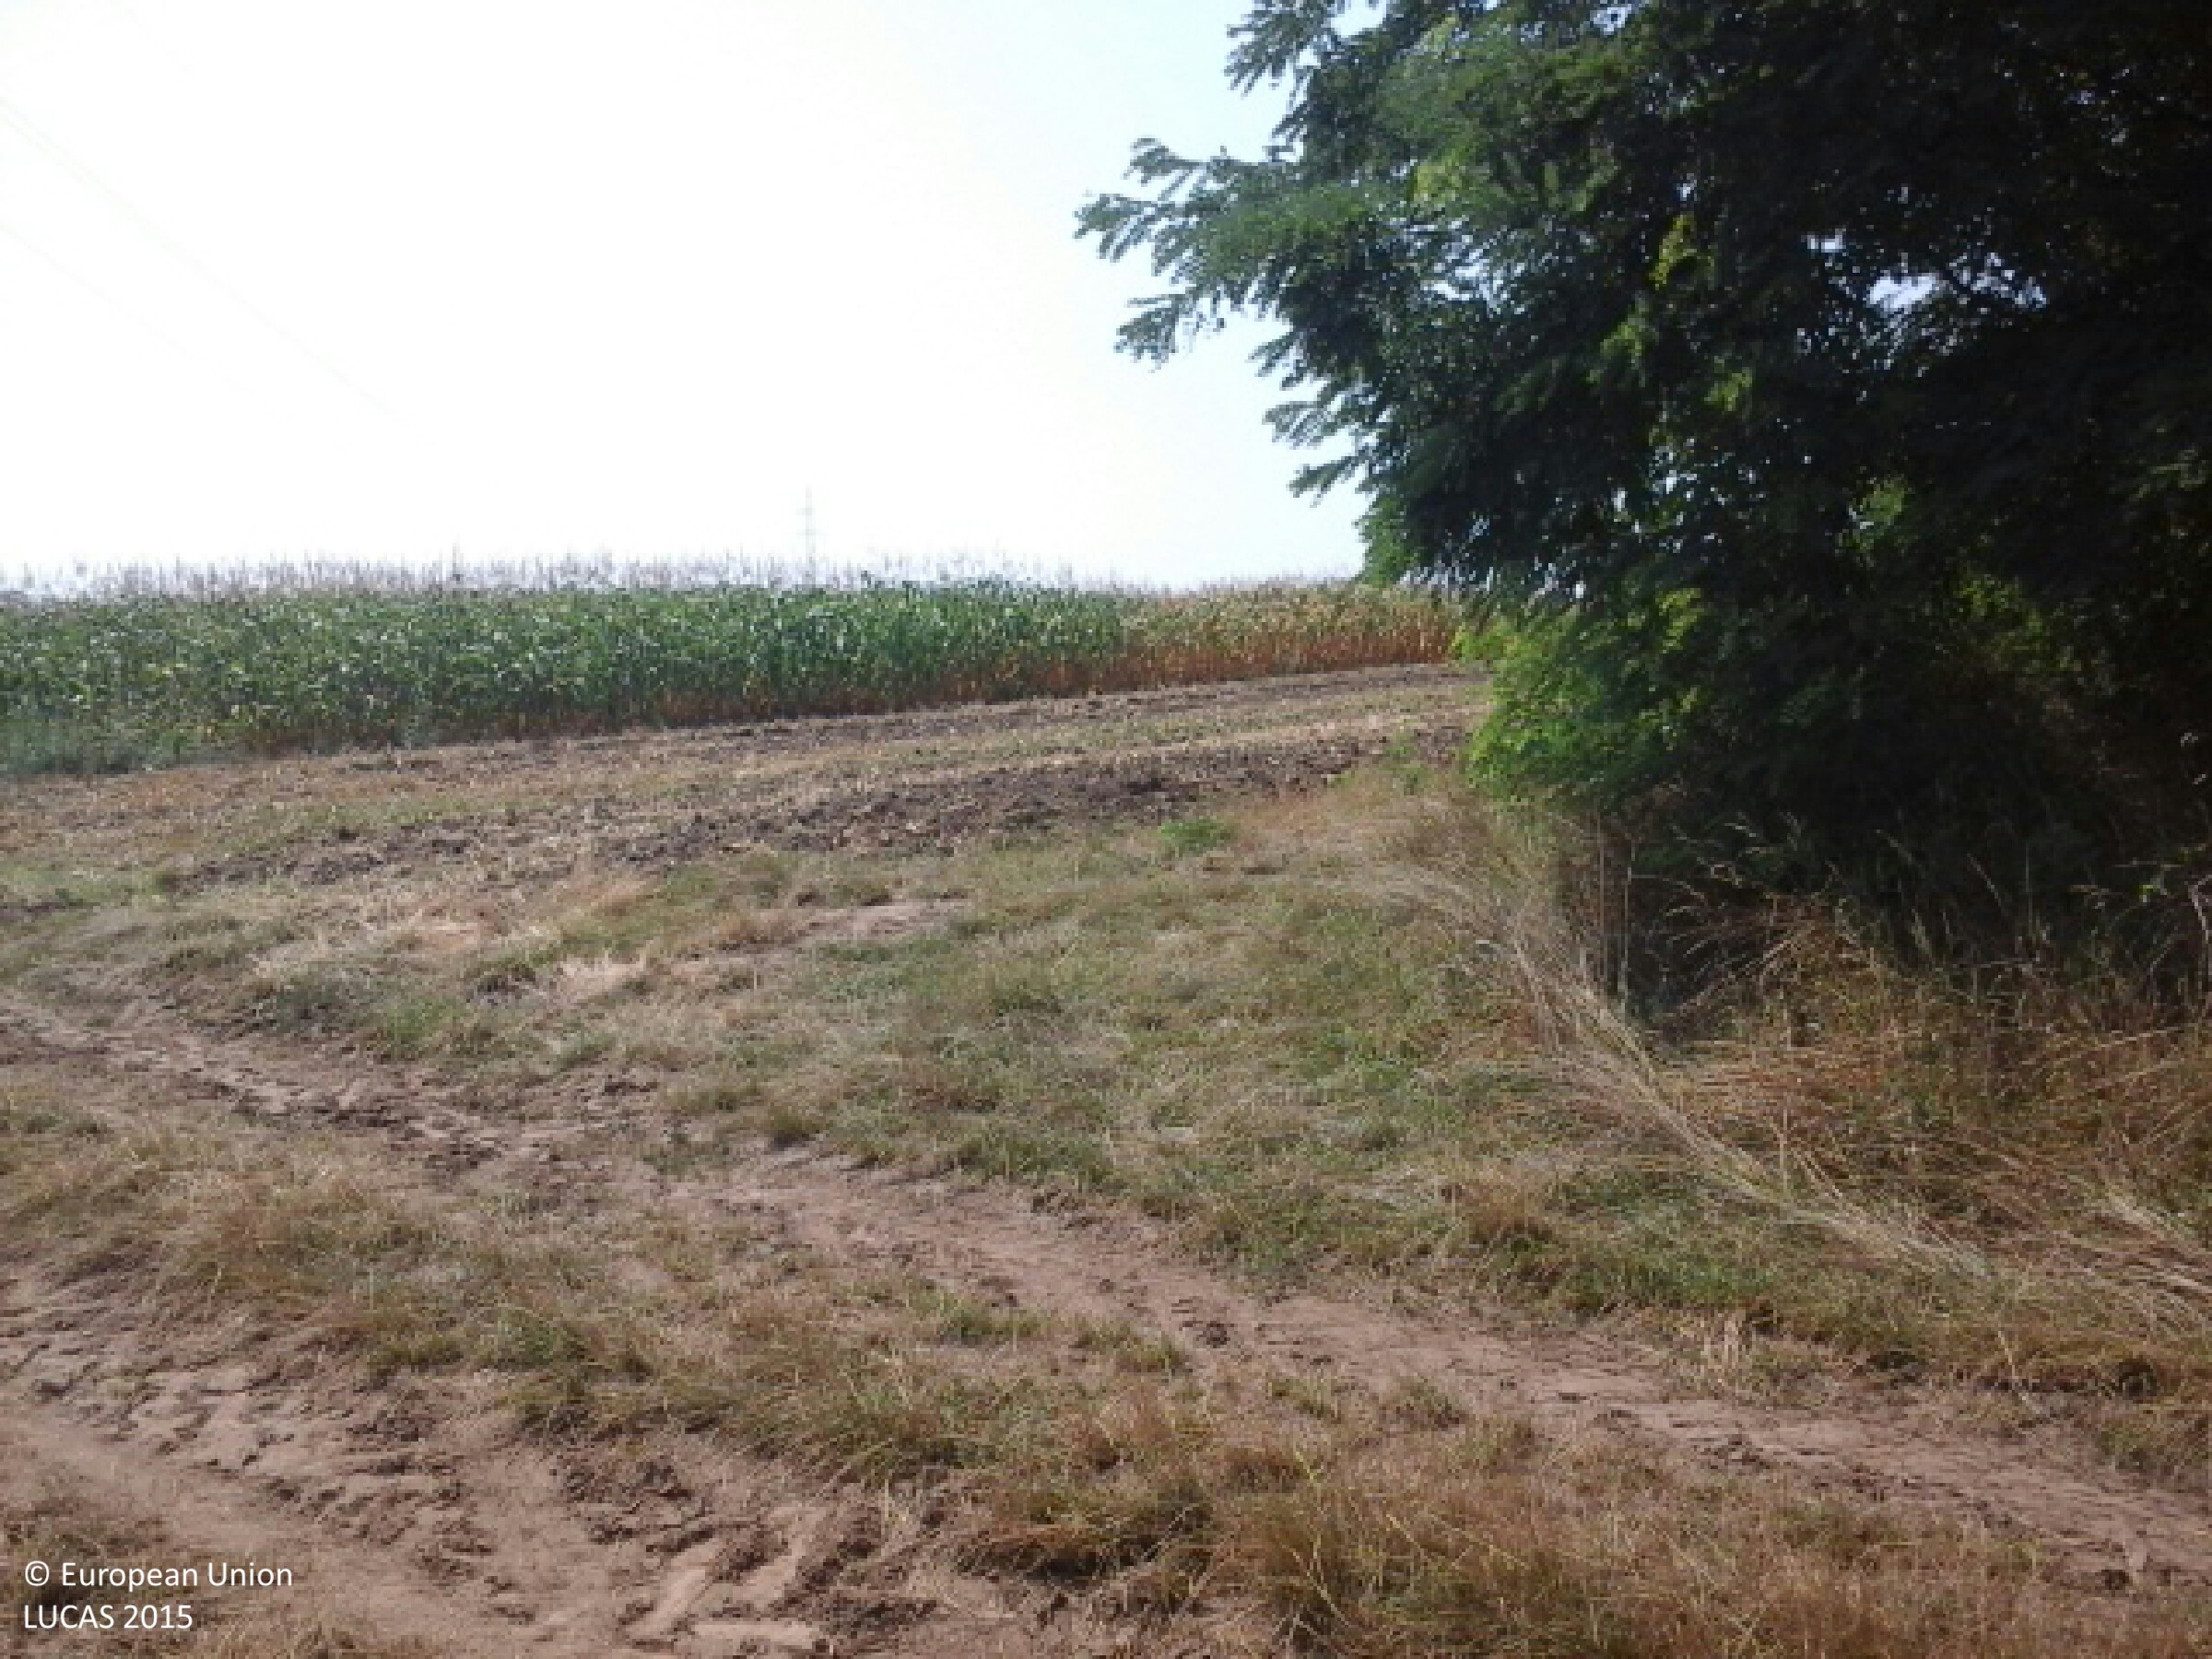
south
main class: Cropland
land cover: Common wheat
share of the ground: < 10 %
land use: Agriculture (excluding fallow land and kitchen gardens)
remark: Harvested field
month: August
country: HU
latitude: 47.6186
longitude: 18.0878
